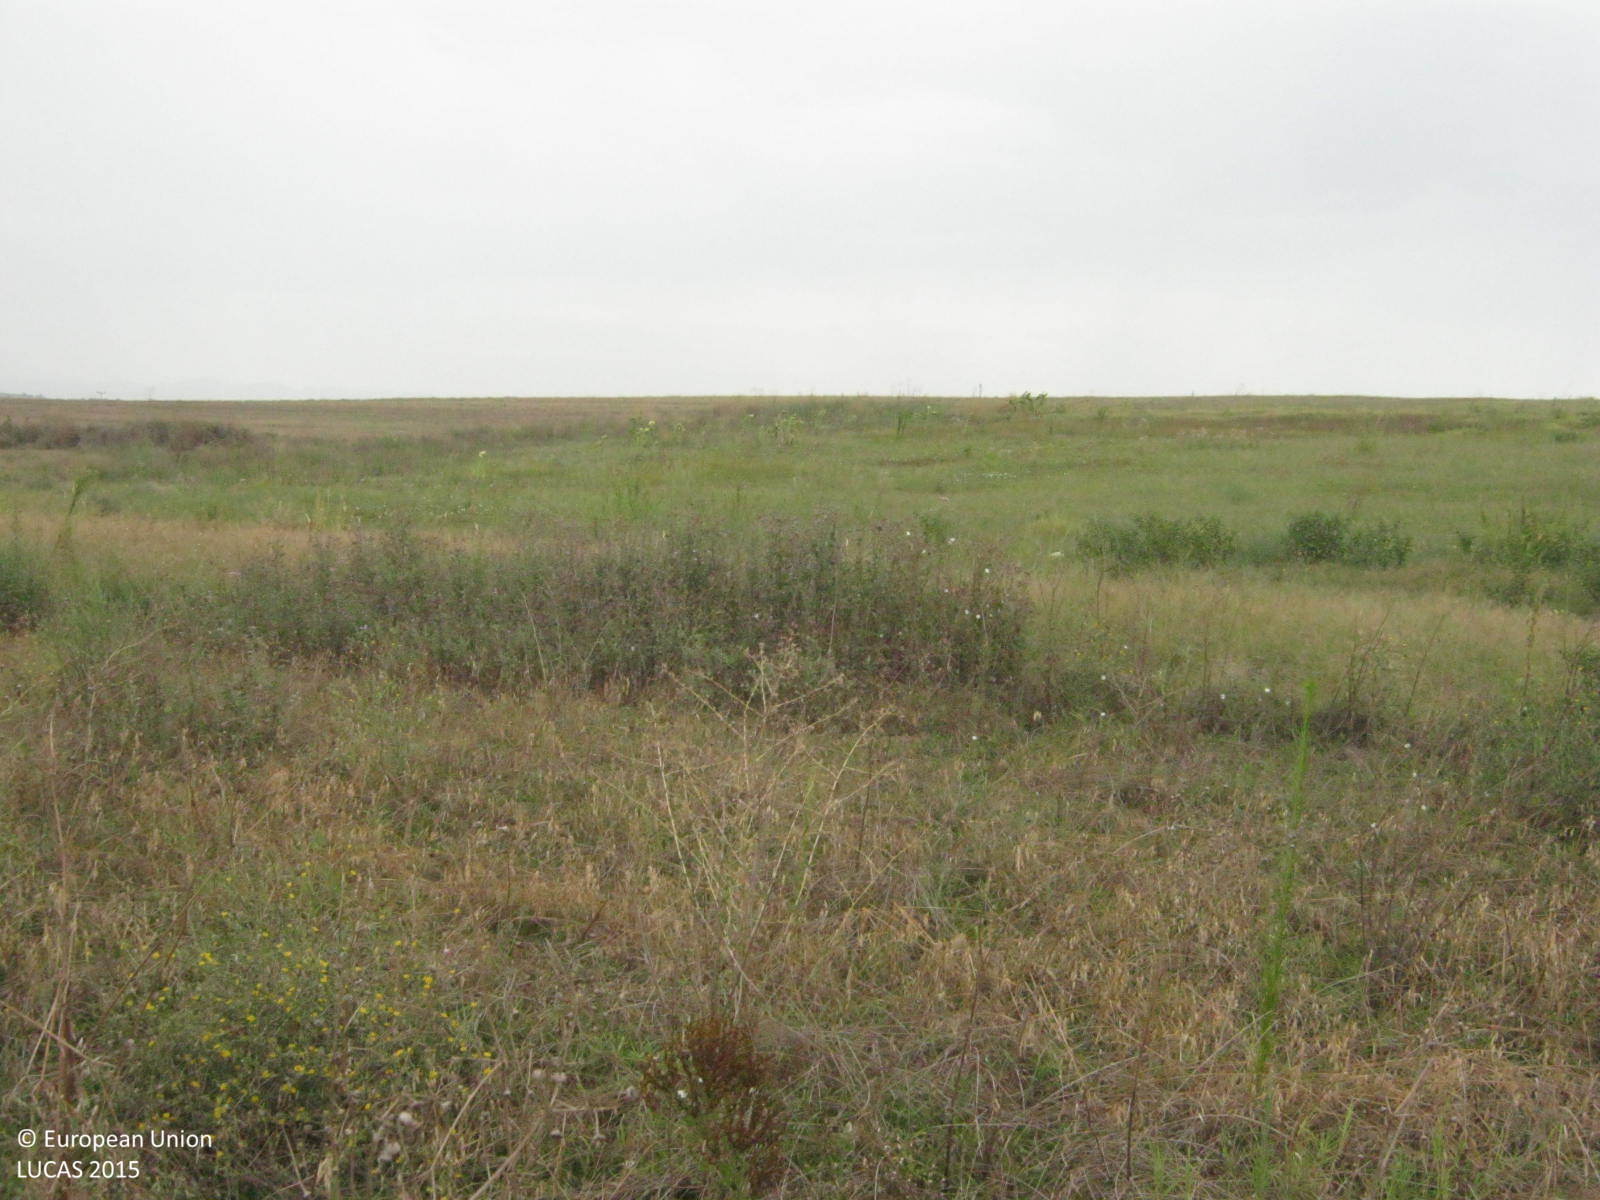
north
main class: Grassland
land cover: Spontaneously vegetated surfaces
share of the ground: > 75 %
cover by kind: herbaceous plants 100 %
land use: Agriculture (excluding fallow land and kitchen gardens)
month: August
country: GR
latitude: 40.8857
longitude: 22.9582
